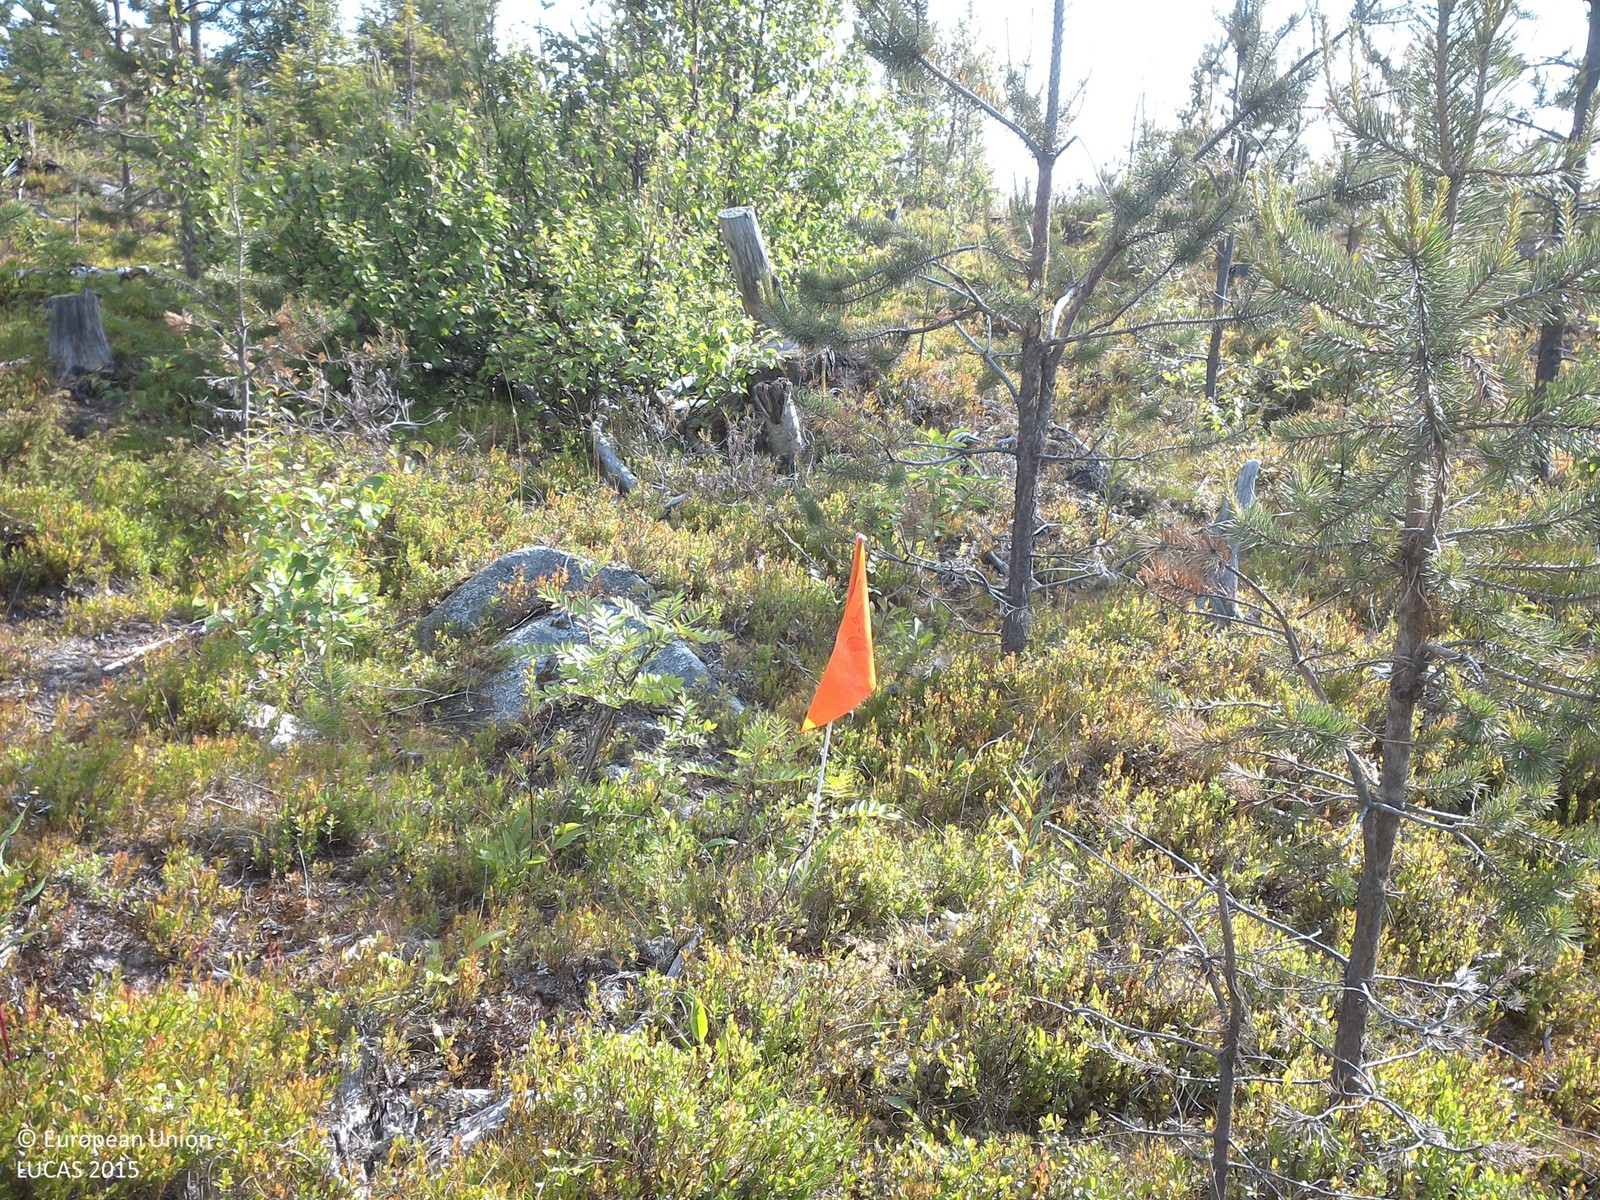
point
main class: Woodland
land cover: Pine dominated mixed woodland
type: boreal forest
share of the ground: 10 - 25 %
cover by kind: shrubs 65 %, coniferous forest trees 15 %, unconsolidated bare surface 10 %, broadleaved forest trees 5 %, lichens and mosses 5 %
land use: Forestry
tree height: < 5 m
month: July
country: SE
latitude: 67.1942
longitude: 23.1707
